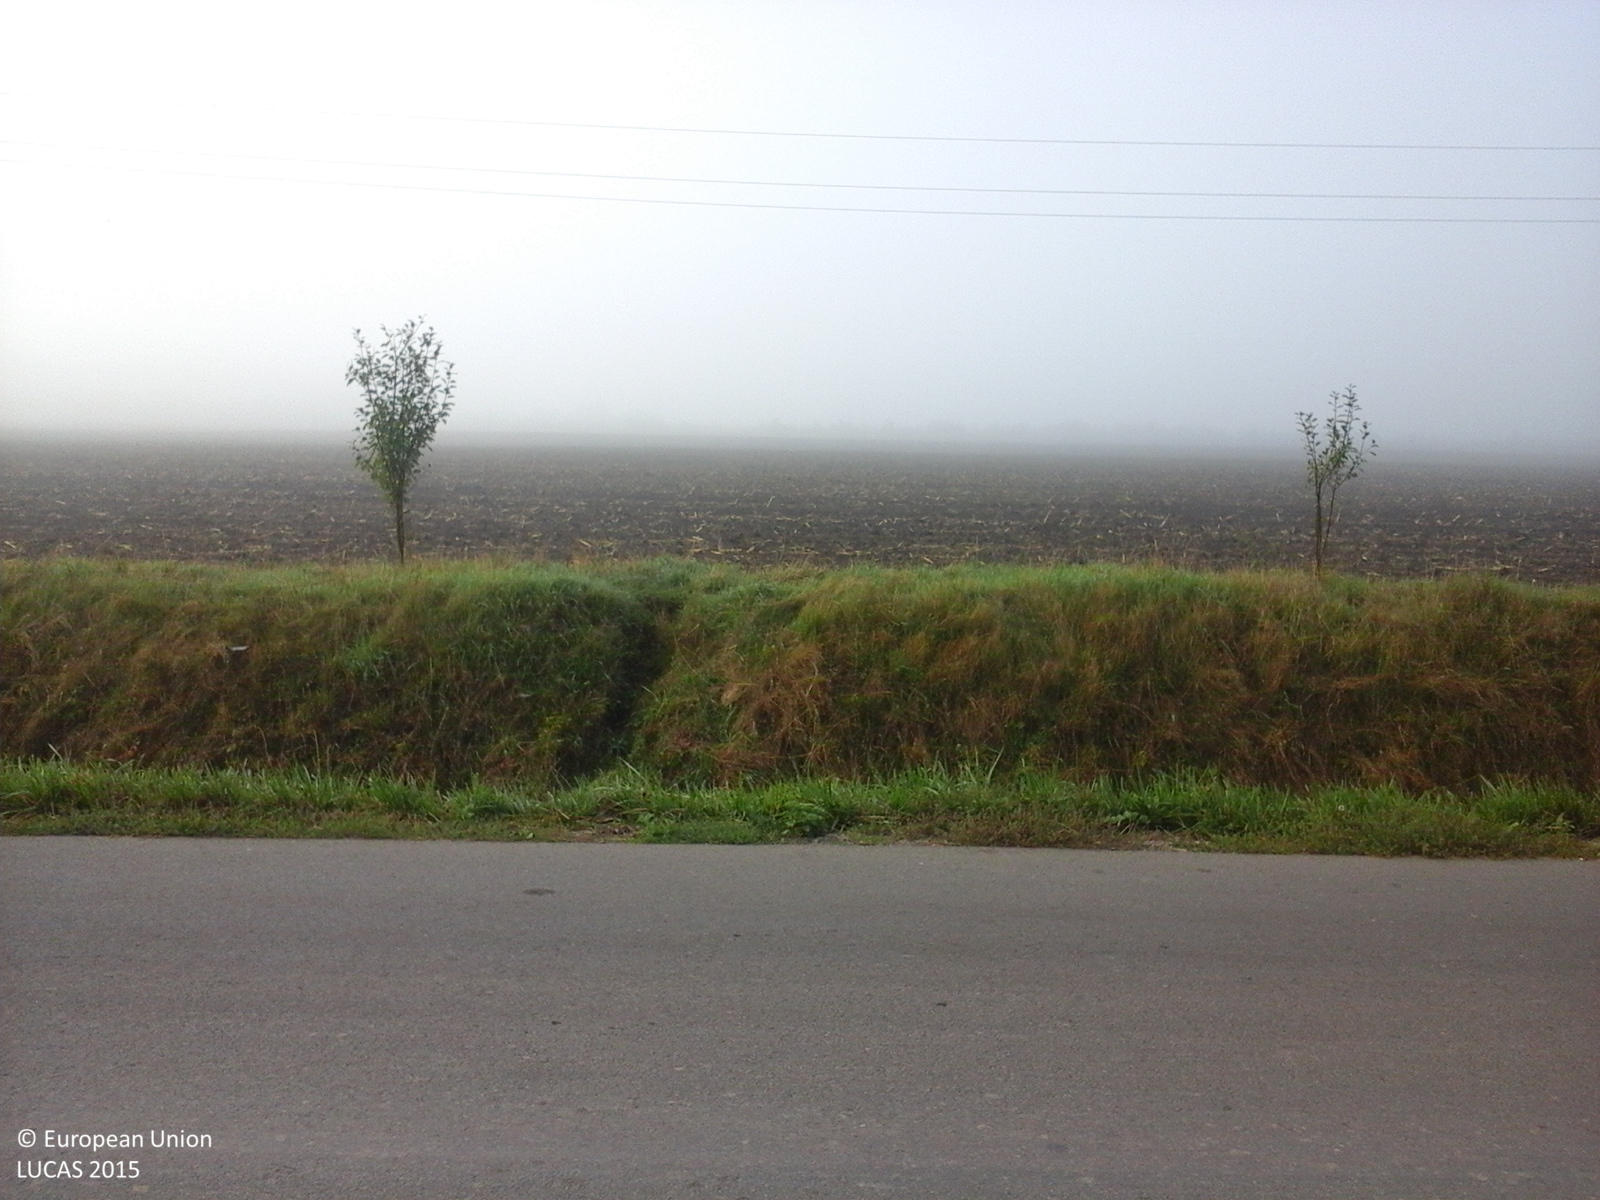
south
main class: Grassland
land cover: Grassland without tree/shrub cover
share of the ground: > 75 %
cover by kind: herbaceous plants 100 %
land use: Agriculture (excluding fallow land and kitchen gardens)
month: September
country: RO
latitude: 46.8598
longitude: 23.7823
